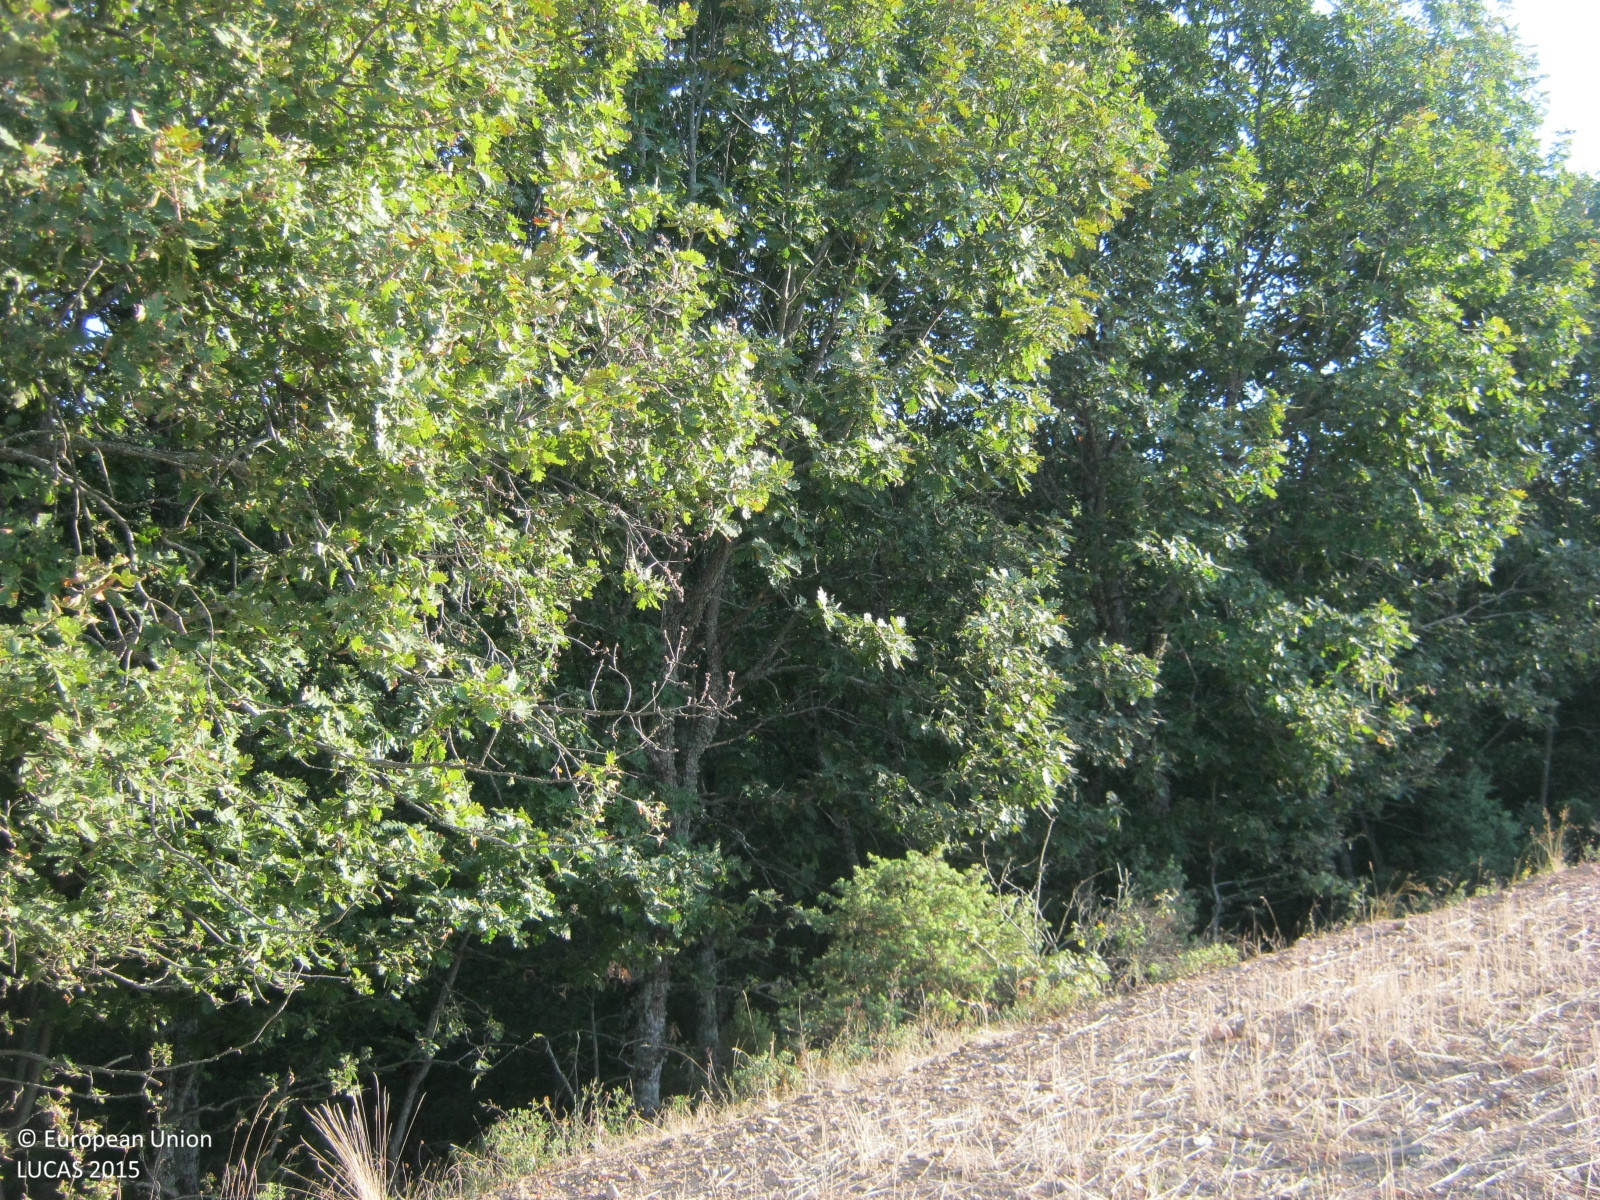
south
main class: Cropland
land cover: Durum wheat
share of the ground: > 75 %
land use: Agriculture (excluding fallow land and kitchen gardens)
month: September
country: GR
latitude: 40.4496
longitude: 23.3453
